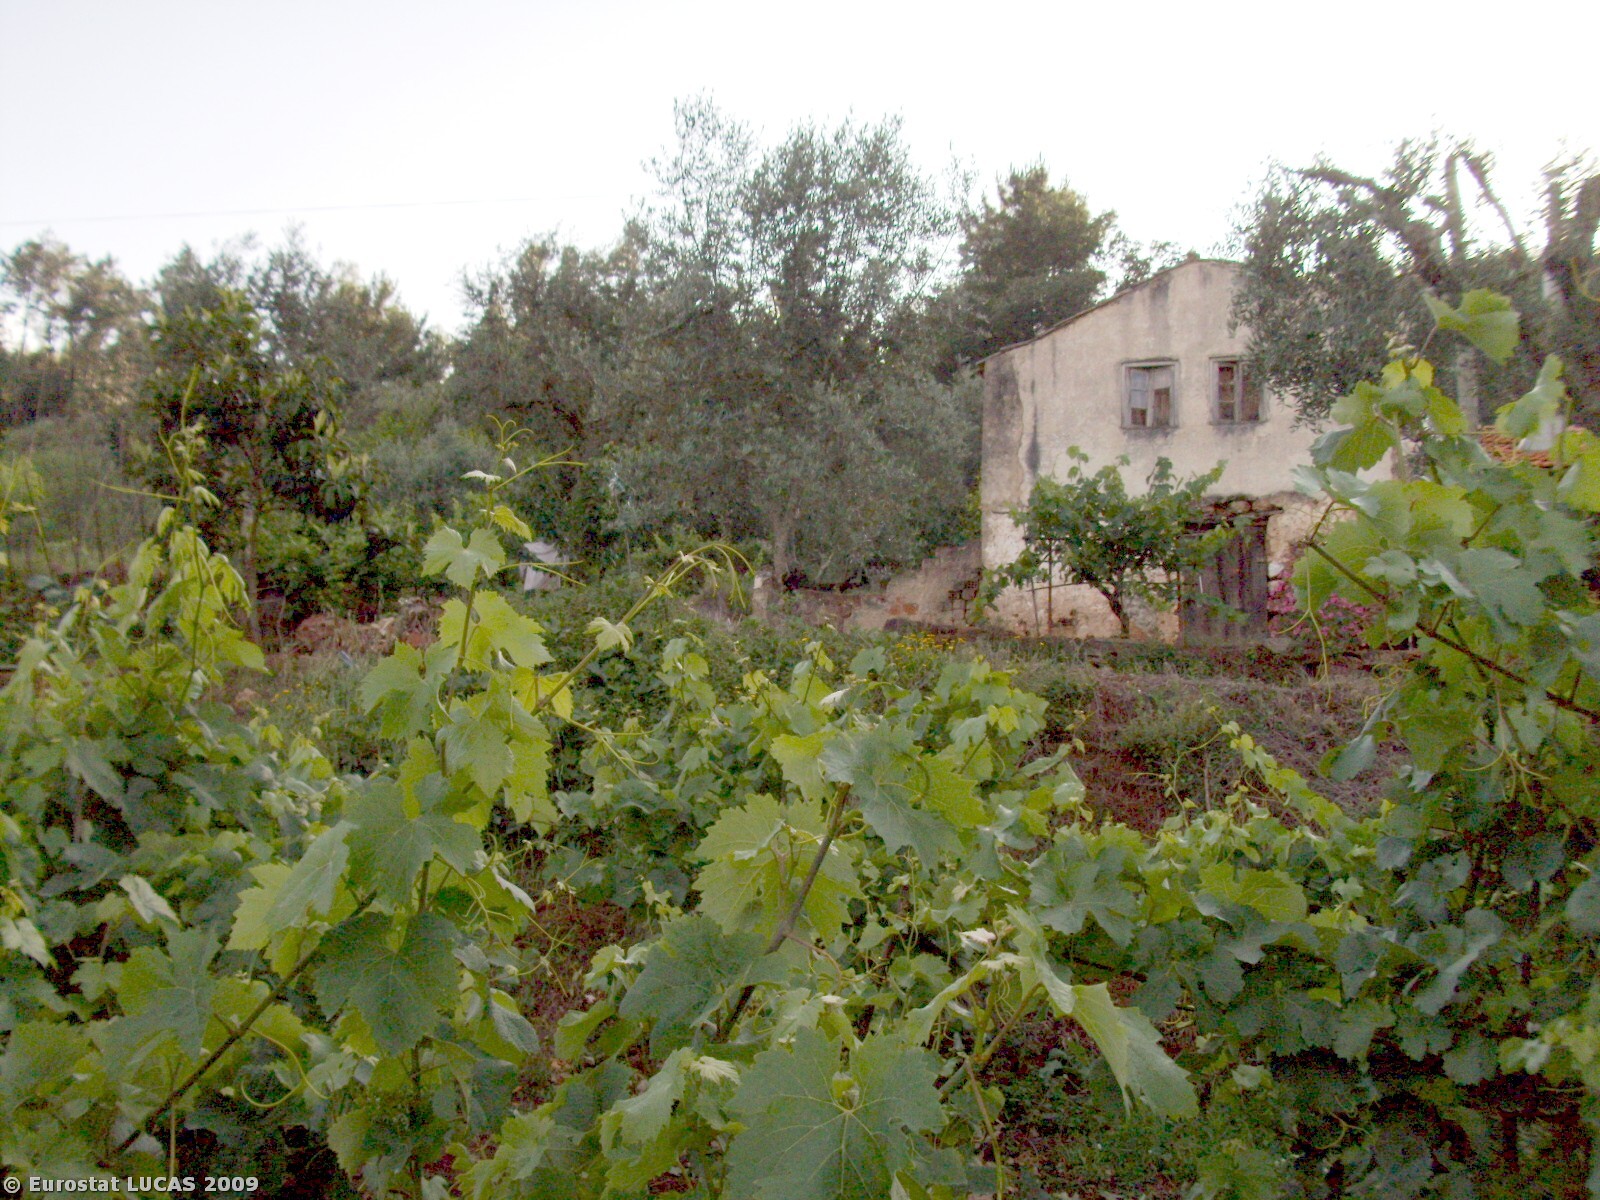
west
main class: Cropland
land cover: Vineyards
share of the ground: > 75 %
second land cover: Bare land
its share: 10 - 25 %
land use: Agriculture (excluding fallow land and kitchen gardens)
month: June
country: PT
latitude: 39.8834
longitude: -8.3764
